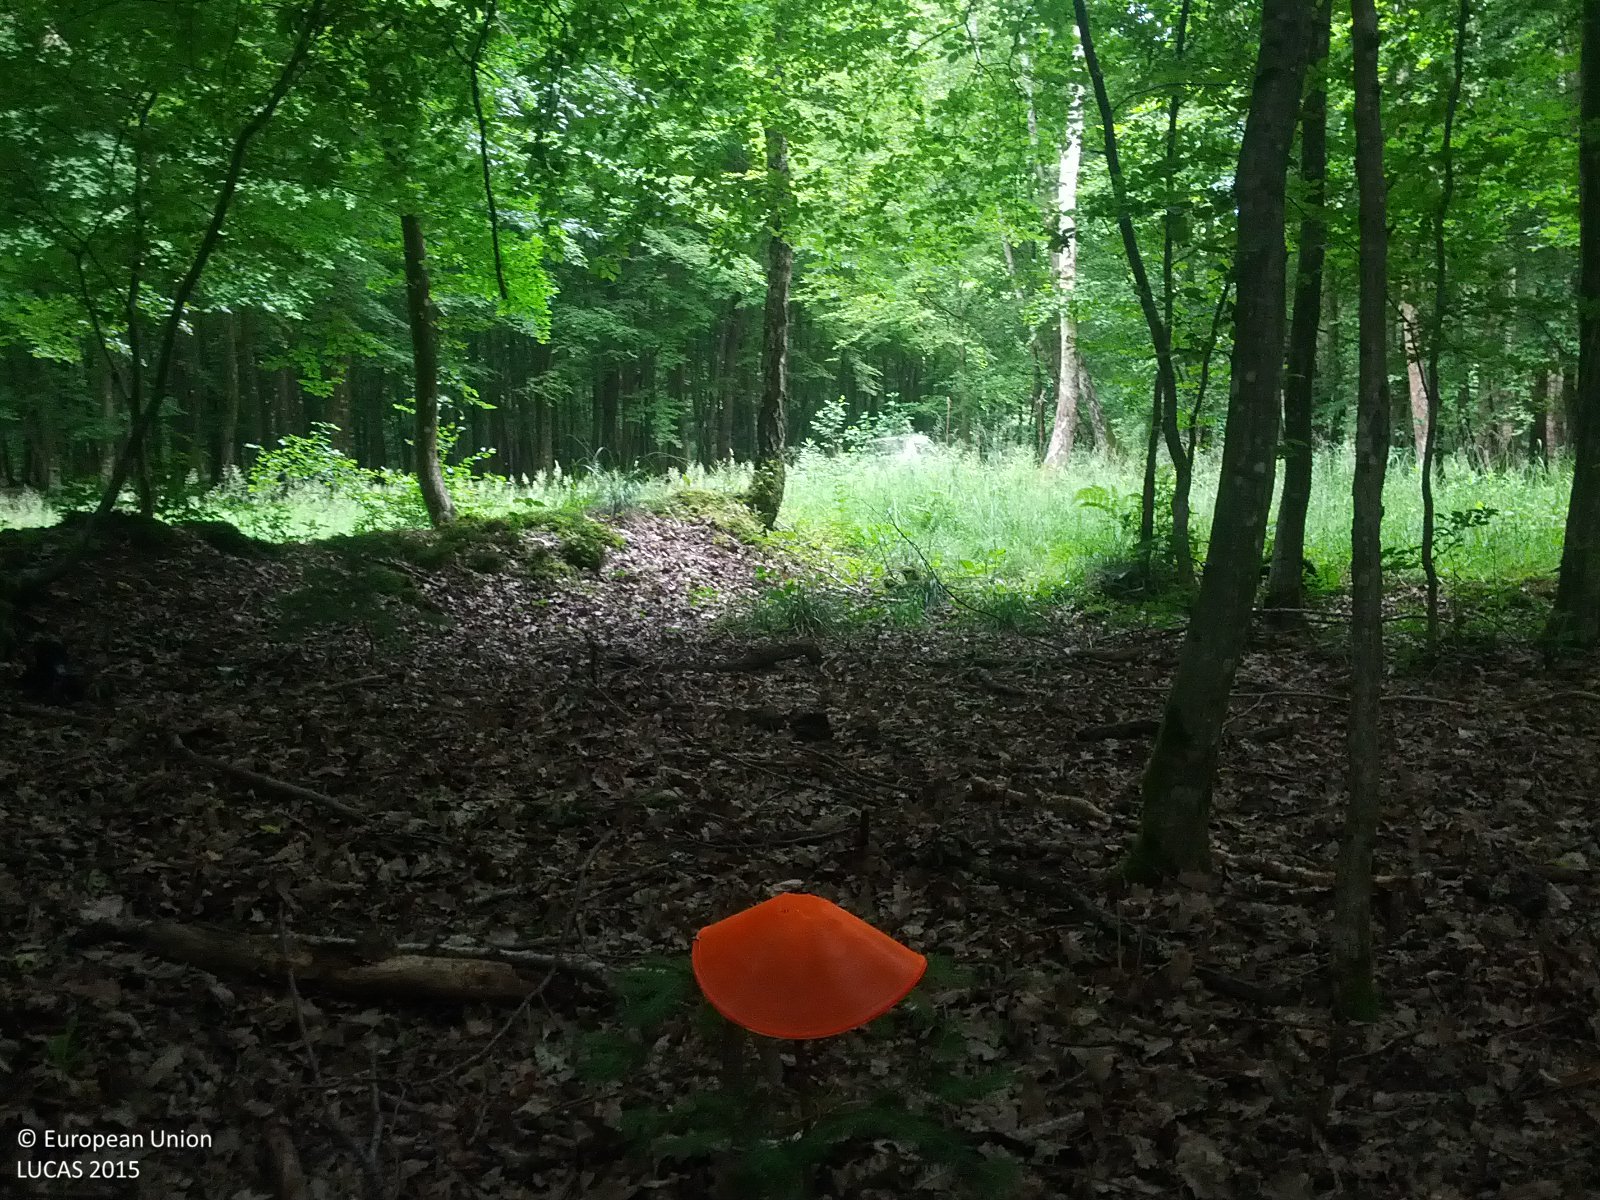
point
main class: Woodland
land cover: Broadleaved woodland
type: beech forest
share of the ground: > 75 %
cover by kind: broadleaved forest trees 90 %, herbaceous plants 5 %, unconsolidated bare surface 5 %
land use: Forestry
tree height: > 5 m
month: June
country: AT
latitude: 47.0812
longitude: 16.3903
